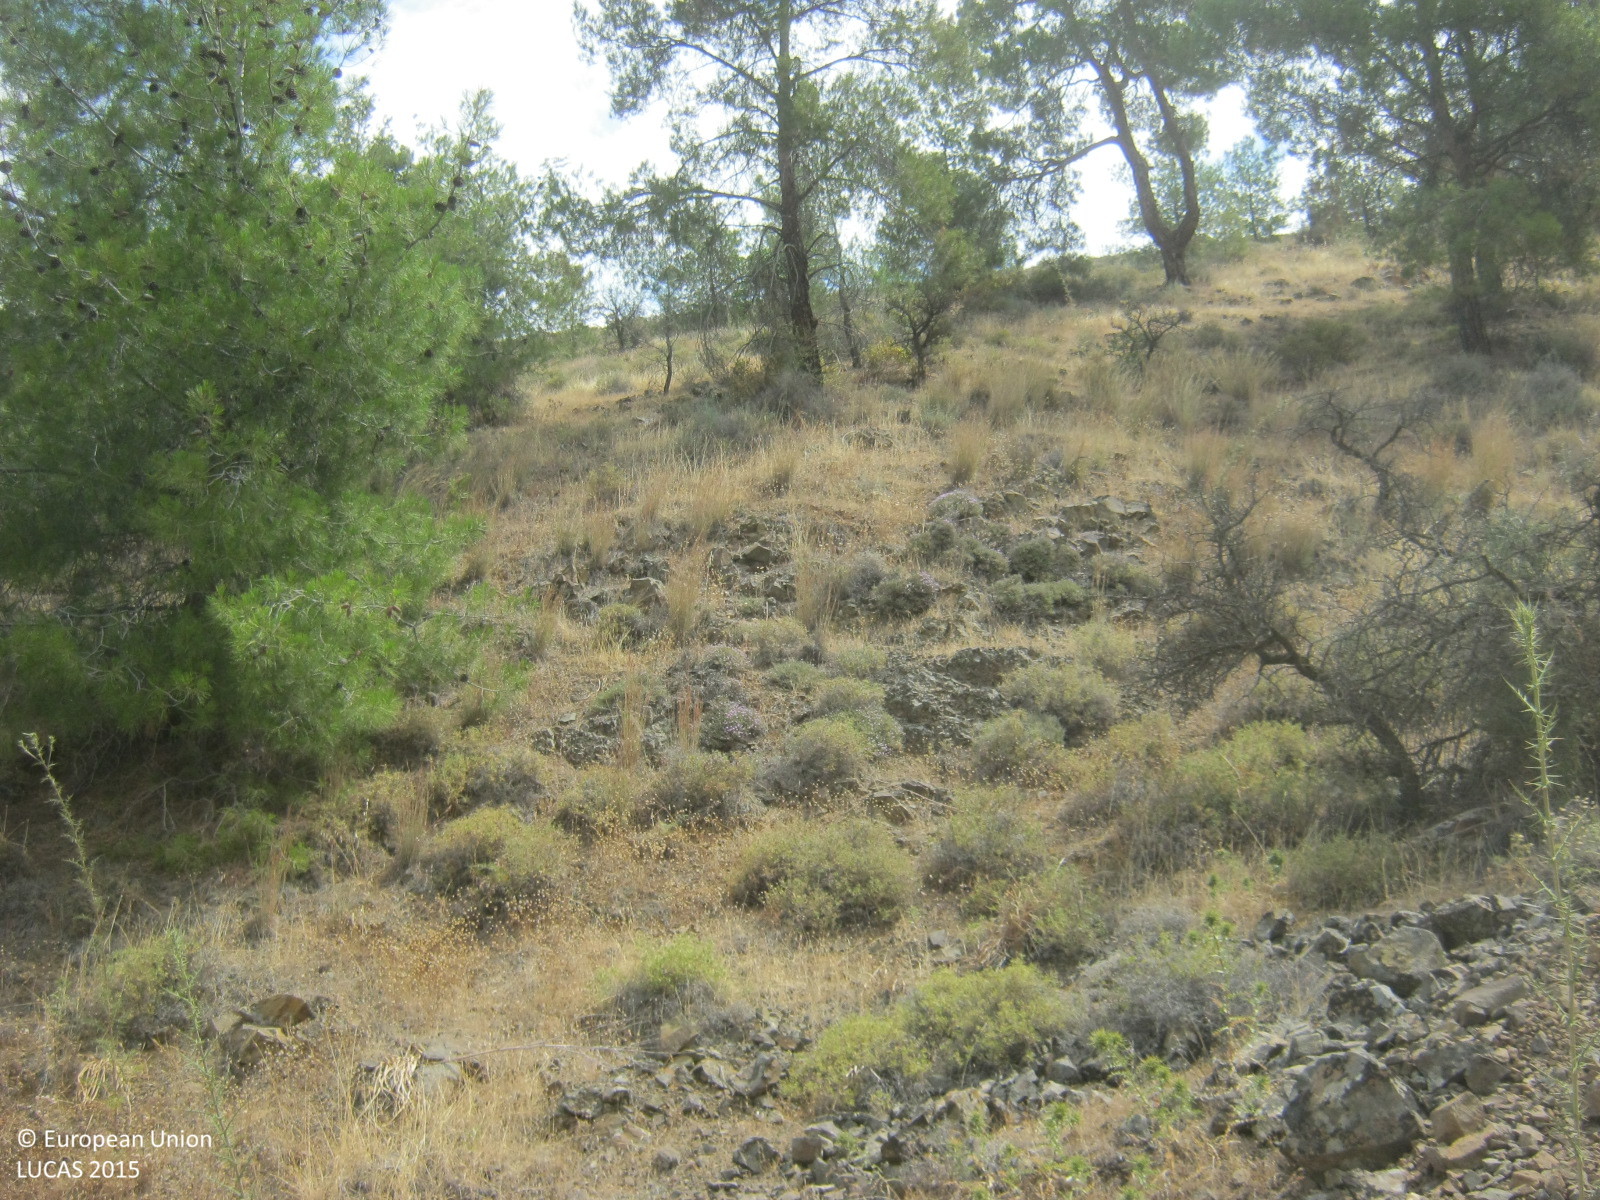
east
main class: Woodland
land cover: Pine dominated coniferous woodland
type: coniferous forest of the mediterranean region
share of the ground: 50 - 75 %
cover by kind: coniferous forest trees 50 %, shrubs 20 %, herbaceous plants 20 %, unconsolidated bare surface 10 %
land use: Forestry
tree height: > 5 m
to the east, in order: Pine dominated coniferous woodland
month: June
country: CY
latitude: 35.0571
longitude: 32.9239
